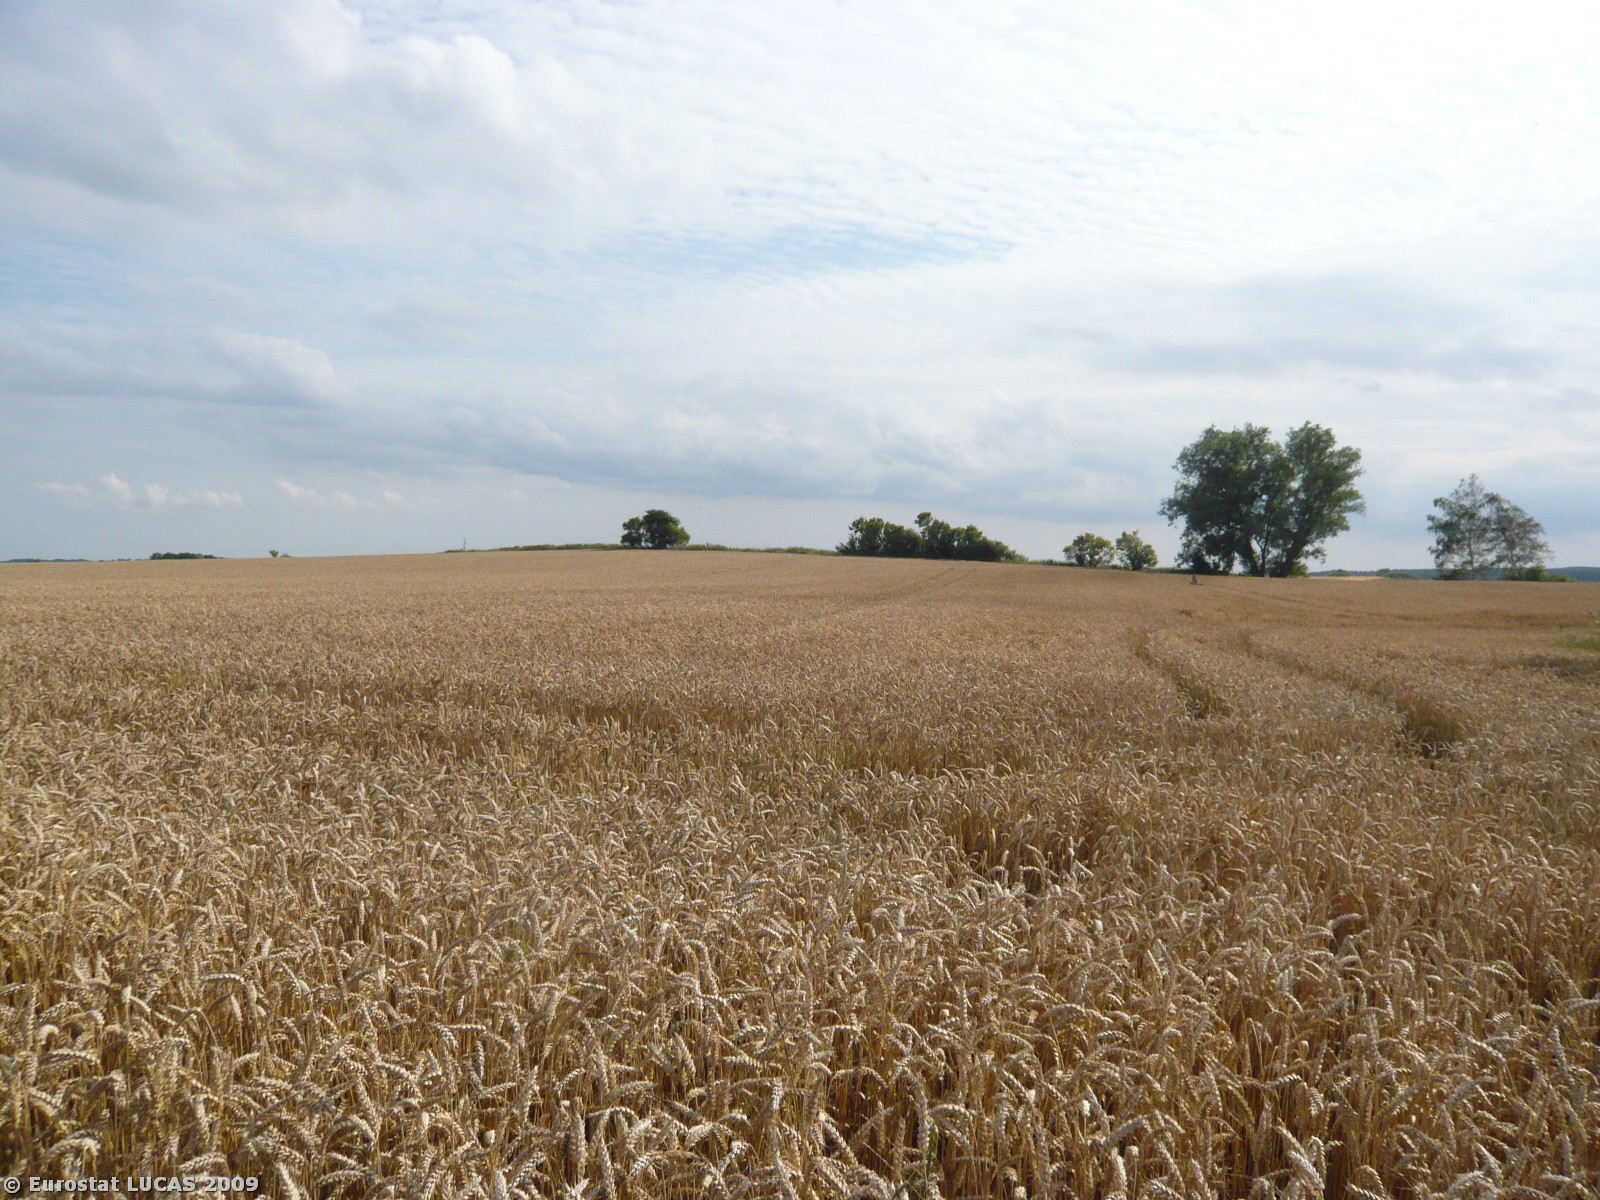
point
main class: Cropland
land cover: Common wheat
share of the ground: > 75 %
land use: Agriculture (excluding fallow land and kitchen gardens)
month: August
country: DK
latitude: 56.0953
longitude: 12.2964
